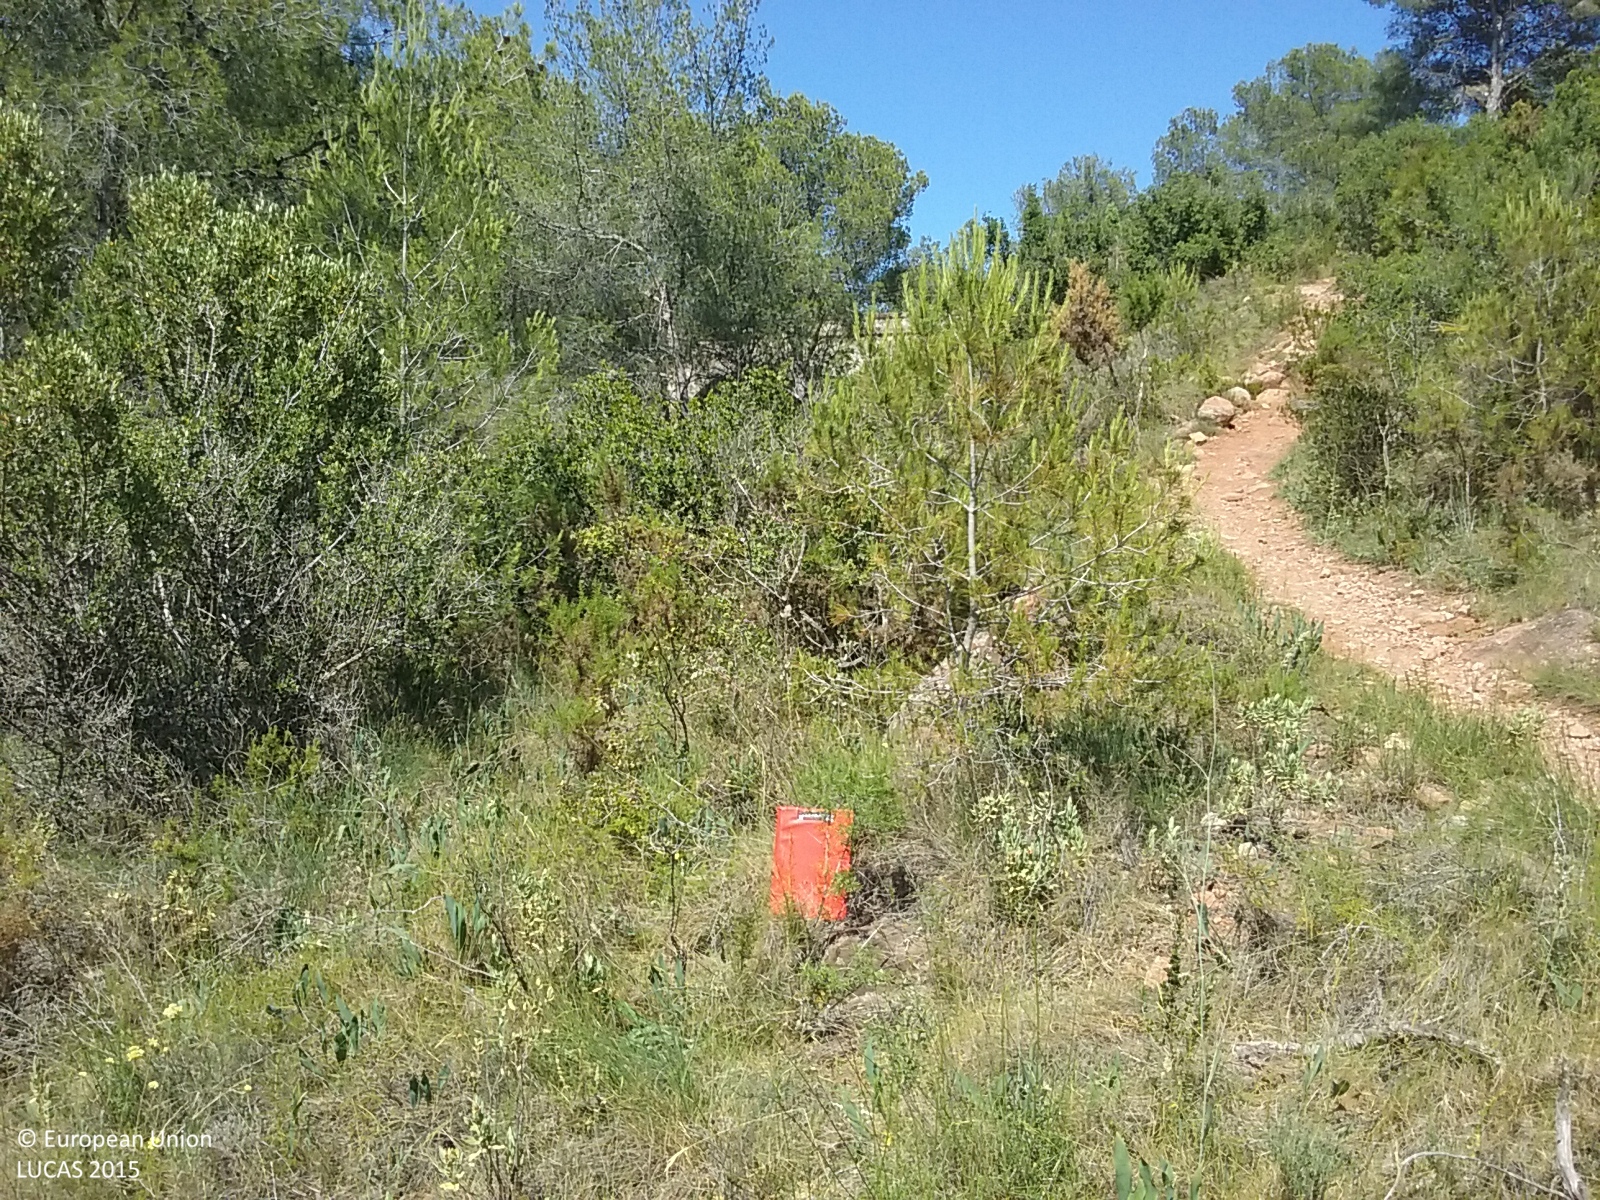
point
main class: Woodland
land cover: Pine dominated mixed woodland
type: coniferous forest of the mediterranean region
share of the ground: 50 - 75 %
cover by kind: coniferous forest trees 65 %, broadleaved forest trees 25 %, shrubs 10 %
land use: Semi-natural and natural areas not in use
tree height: > 5 m
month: June
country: ES
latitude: 40.0467
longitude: 0.0004
